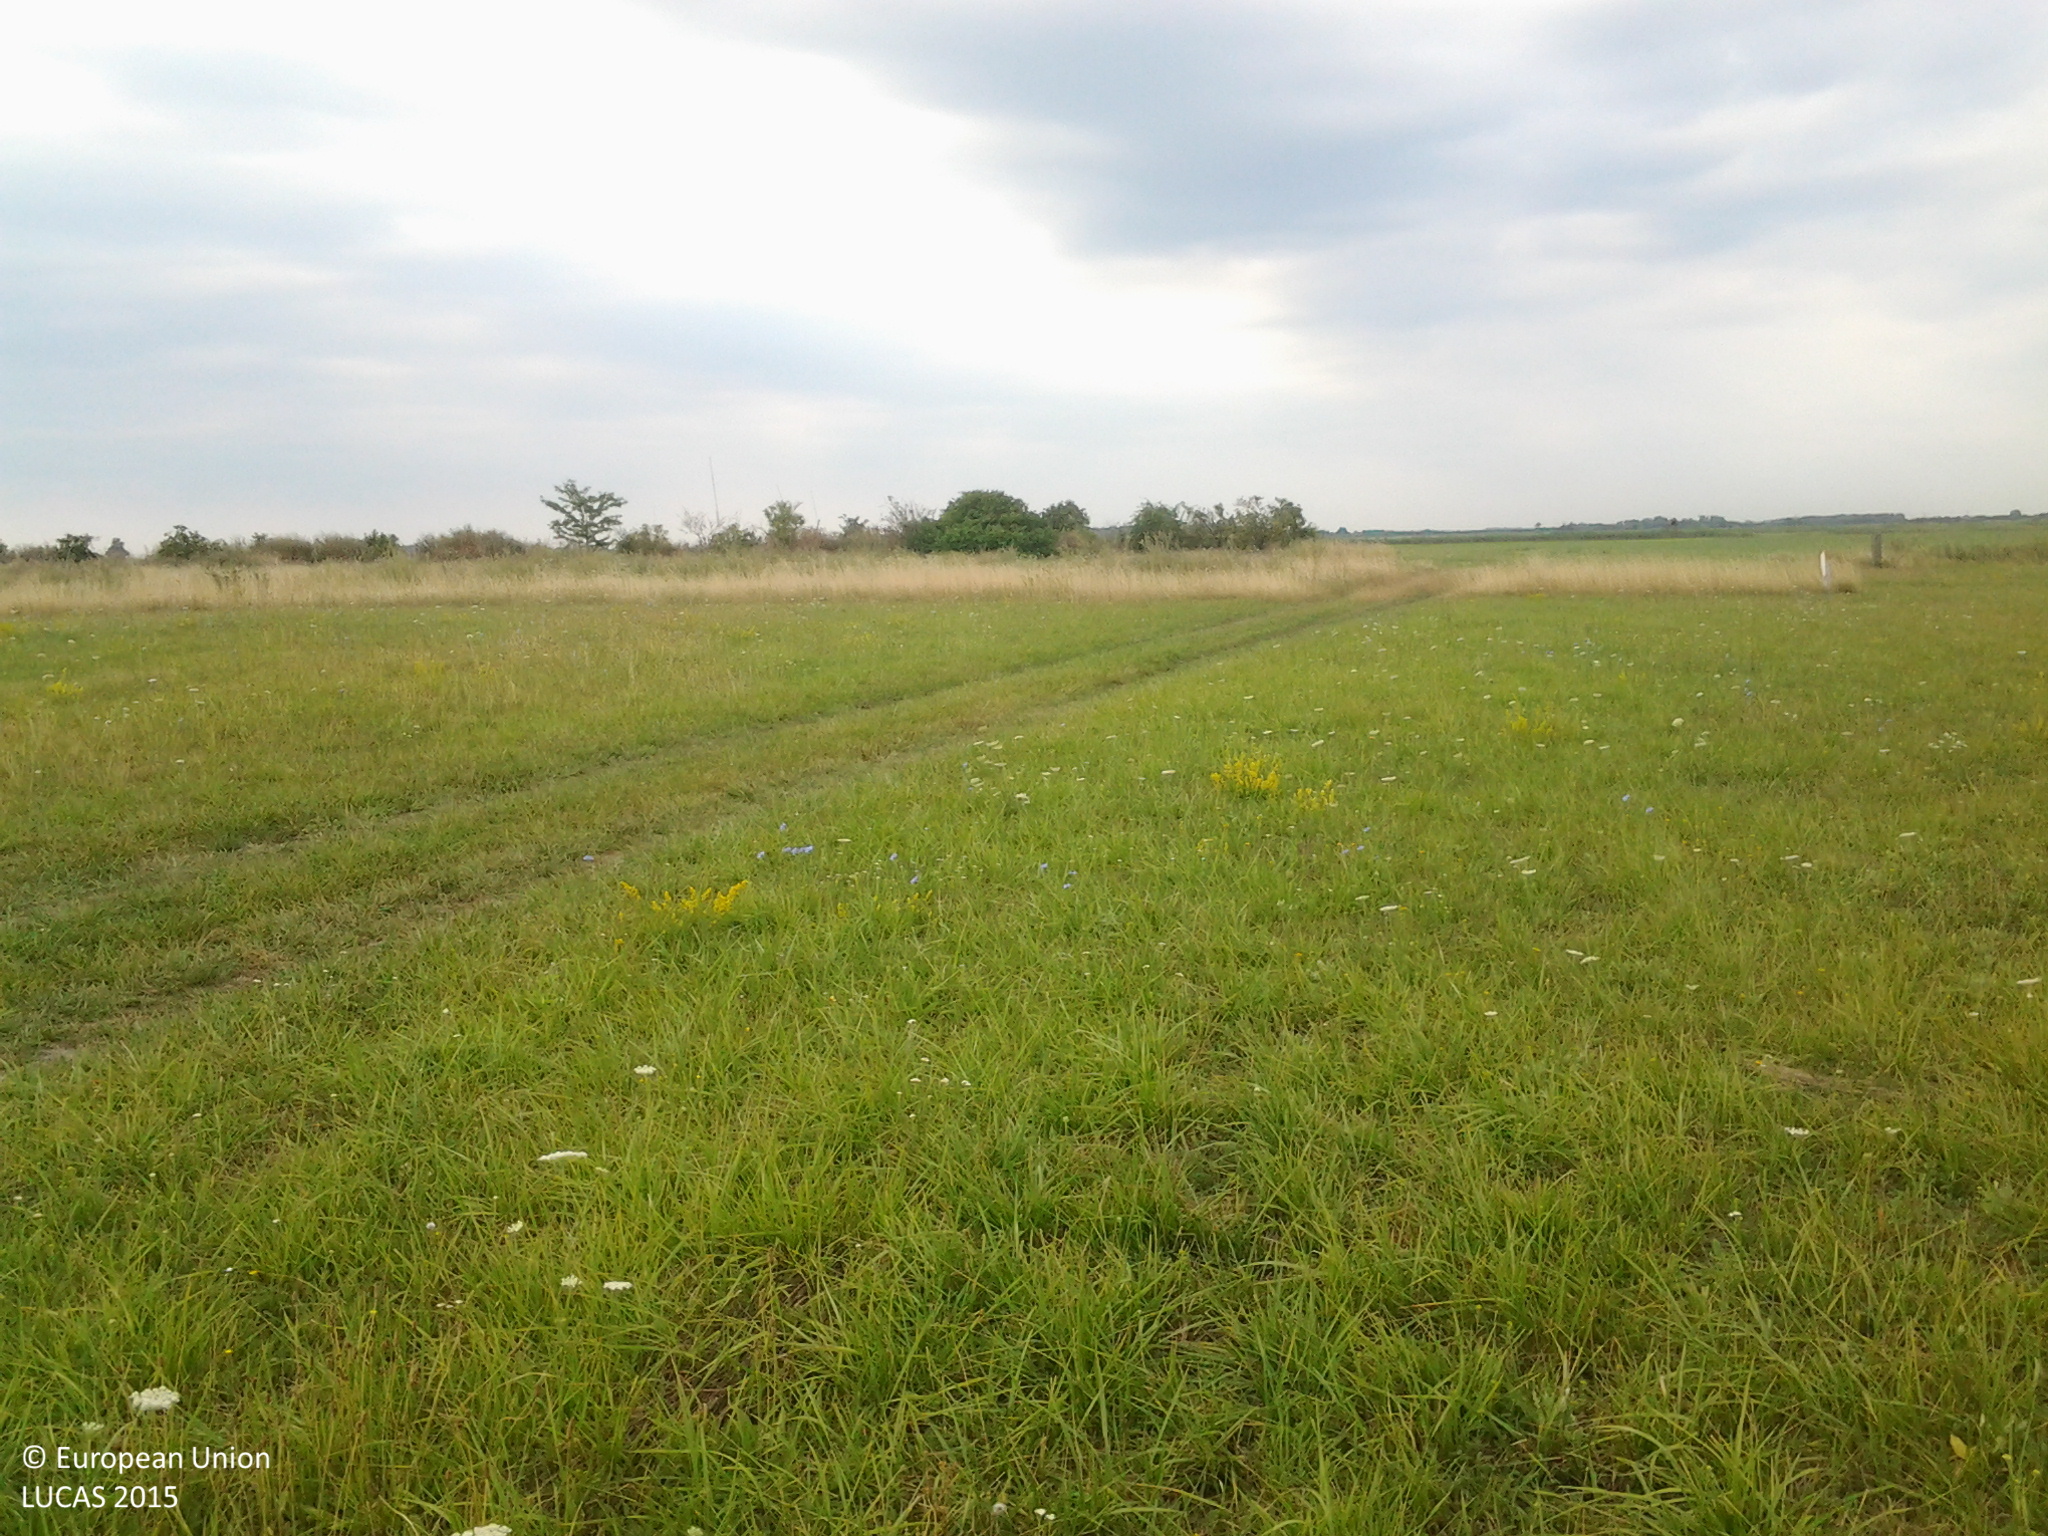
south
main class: Grassland
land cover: Grassland without tree/shrub cover
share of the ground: > 75 %
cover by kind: herbaceous plants 100 %
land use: Agriculture (excluding fallow land and kitchen gardens)
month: July
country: HU
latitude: 46.9481
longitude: 19.0153
